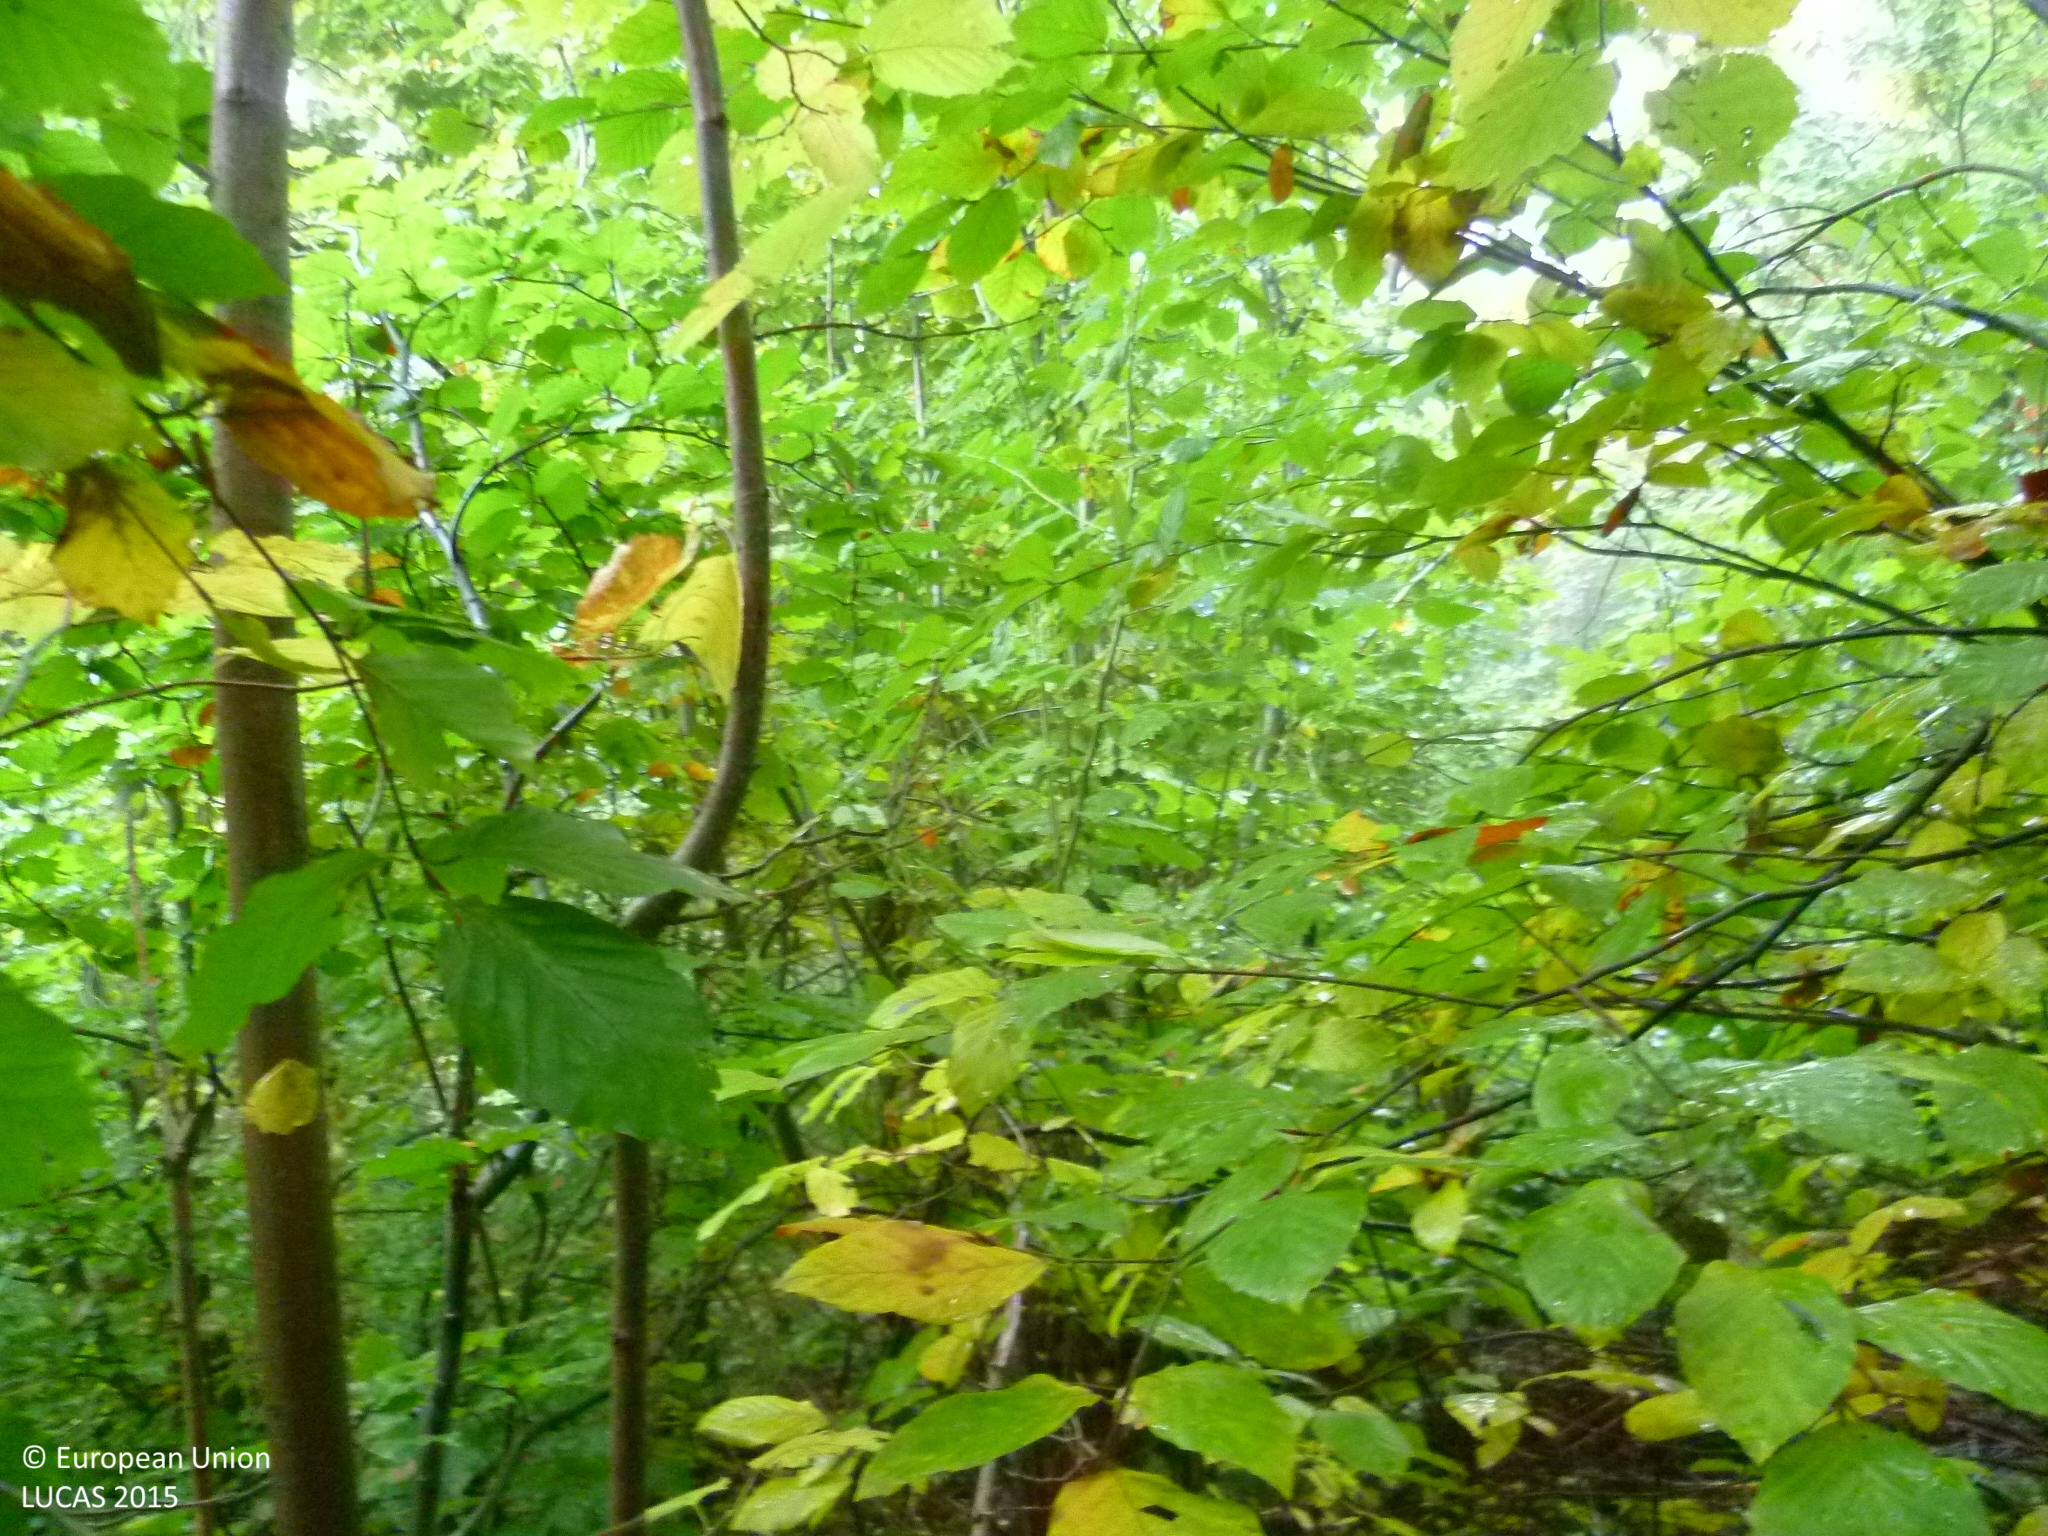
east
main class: Woodland
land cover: Broadleaved woodland
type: beech forest
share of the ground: > 75 %
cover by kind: broadleaved forest trees 80 %, unconsolidated bare surface 15 %, lichens and mosses 5 %
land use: Forestry
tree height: > 5 m
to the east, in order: Broadleaved woodland; Pine dominated coniferous woodland; Tracks; Pine dominated coniferous woodland; Pine dominated mixed woodland; Grassland without tree/shrub cover; Tracks; Broadleaved woodland; Grass margins; Tracks
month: October
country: BG
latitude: 42.3543
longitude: 23.5956
